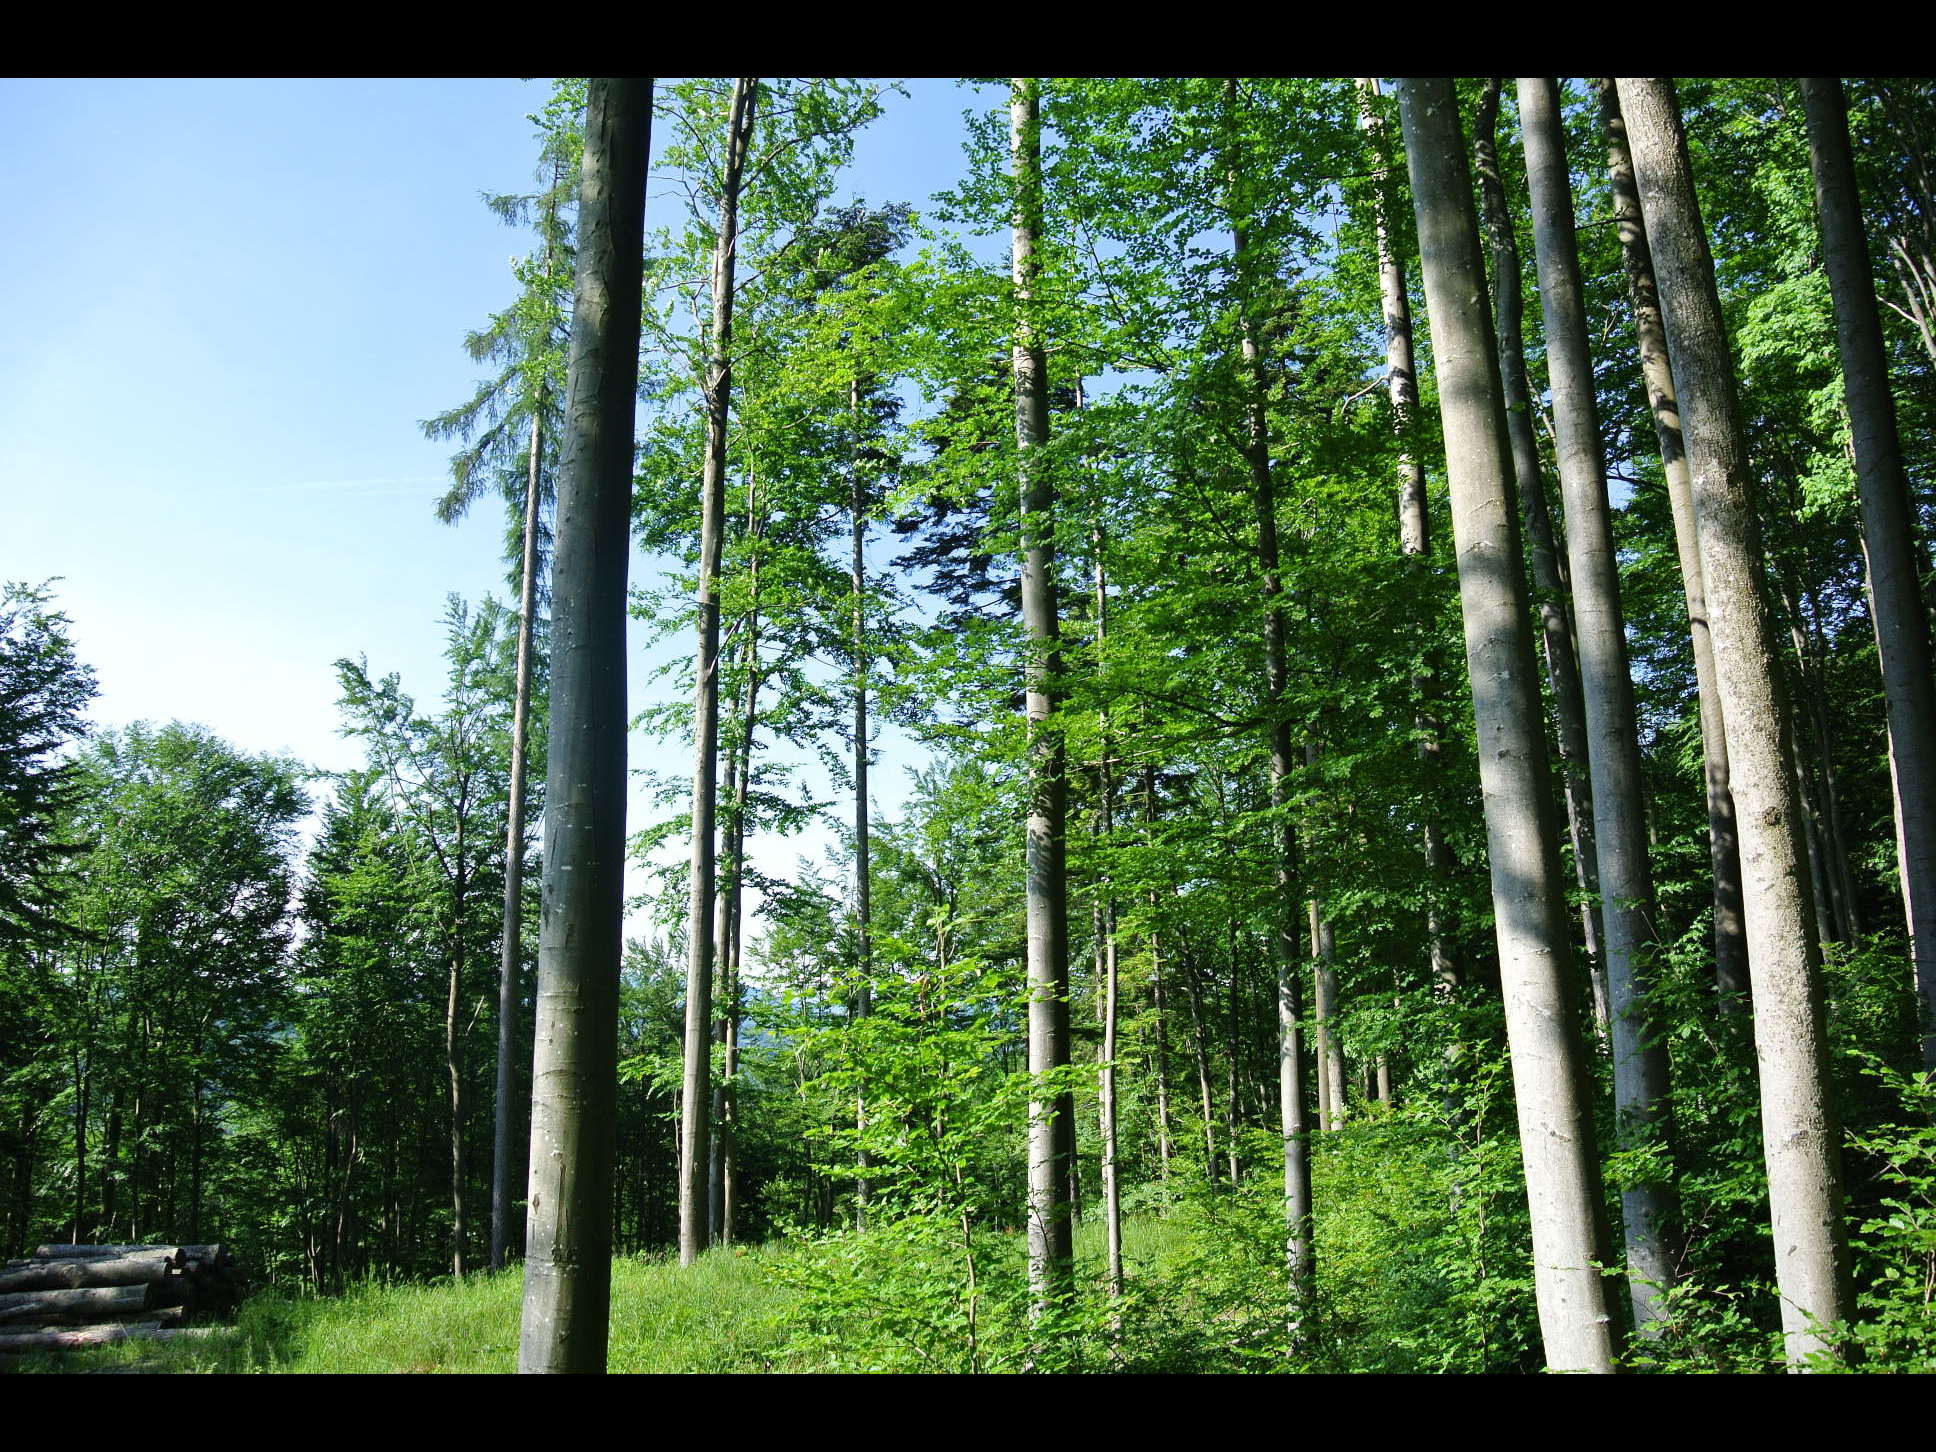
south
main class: Woodland
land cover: Spruce dominated mixed woodland
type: alpine coniferous forest
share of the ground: > 75 %
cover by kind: coniferous forest trees 60 %, broadleaved forest trees 40 %
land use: Forestry
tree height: > 5 m
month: May
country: AT
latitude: 48.0687
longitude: 15.8408
